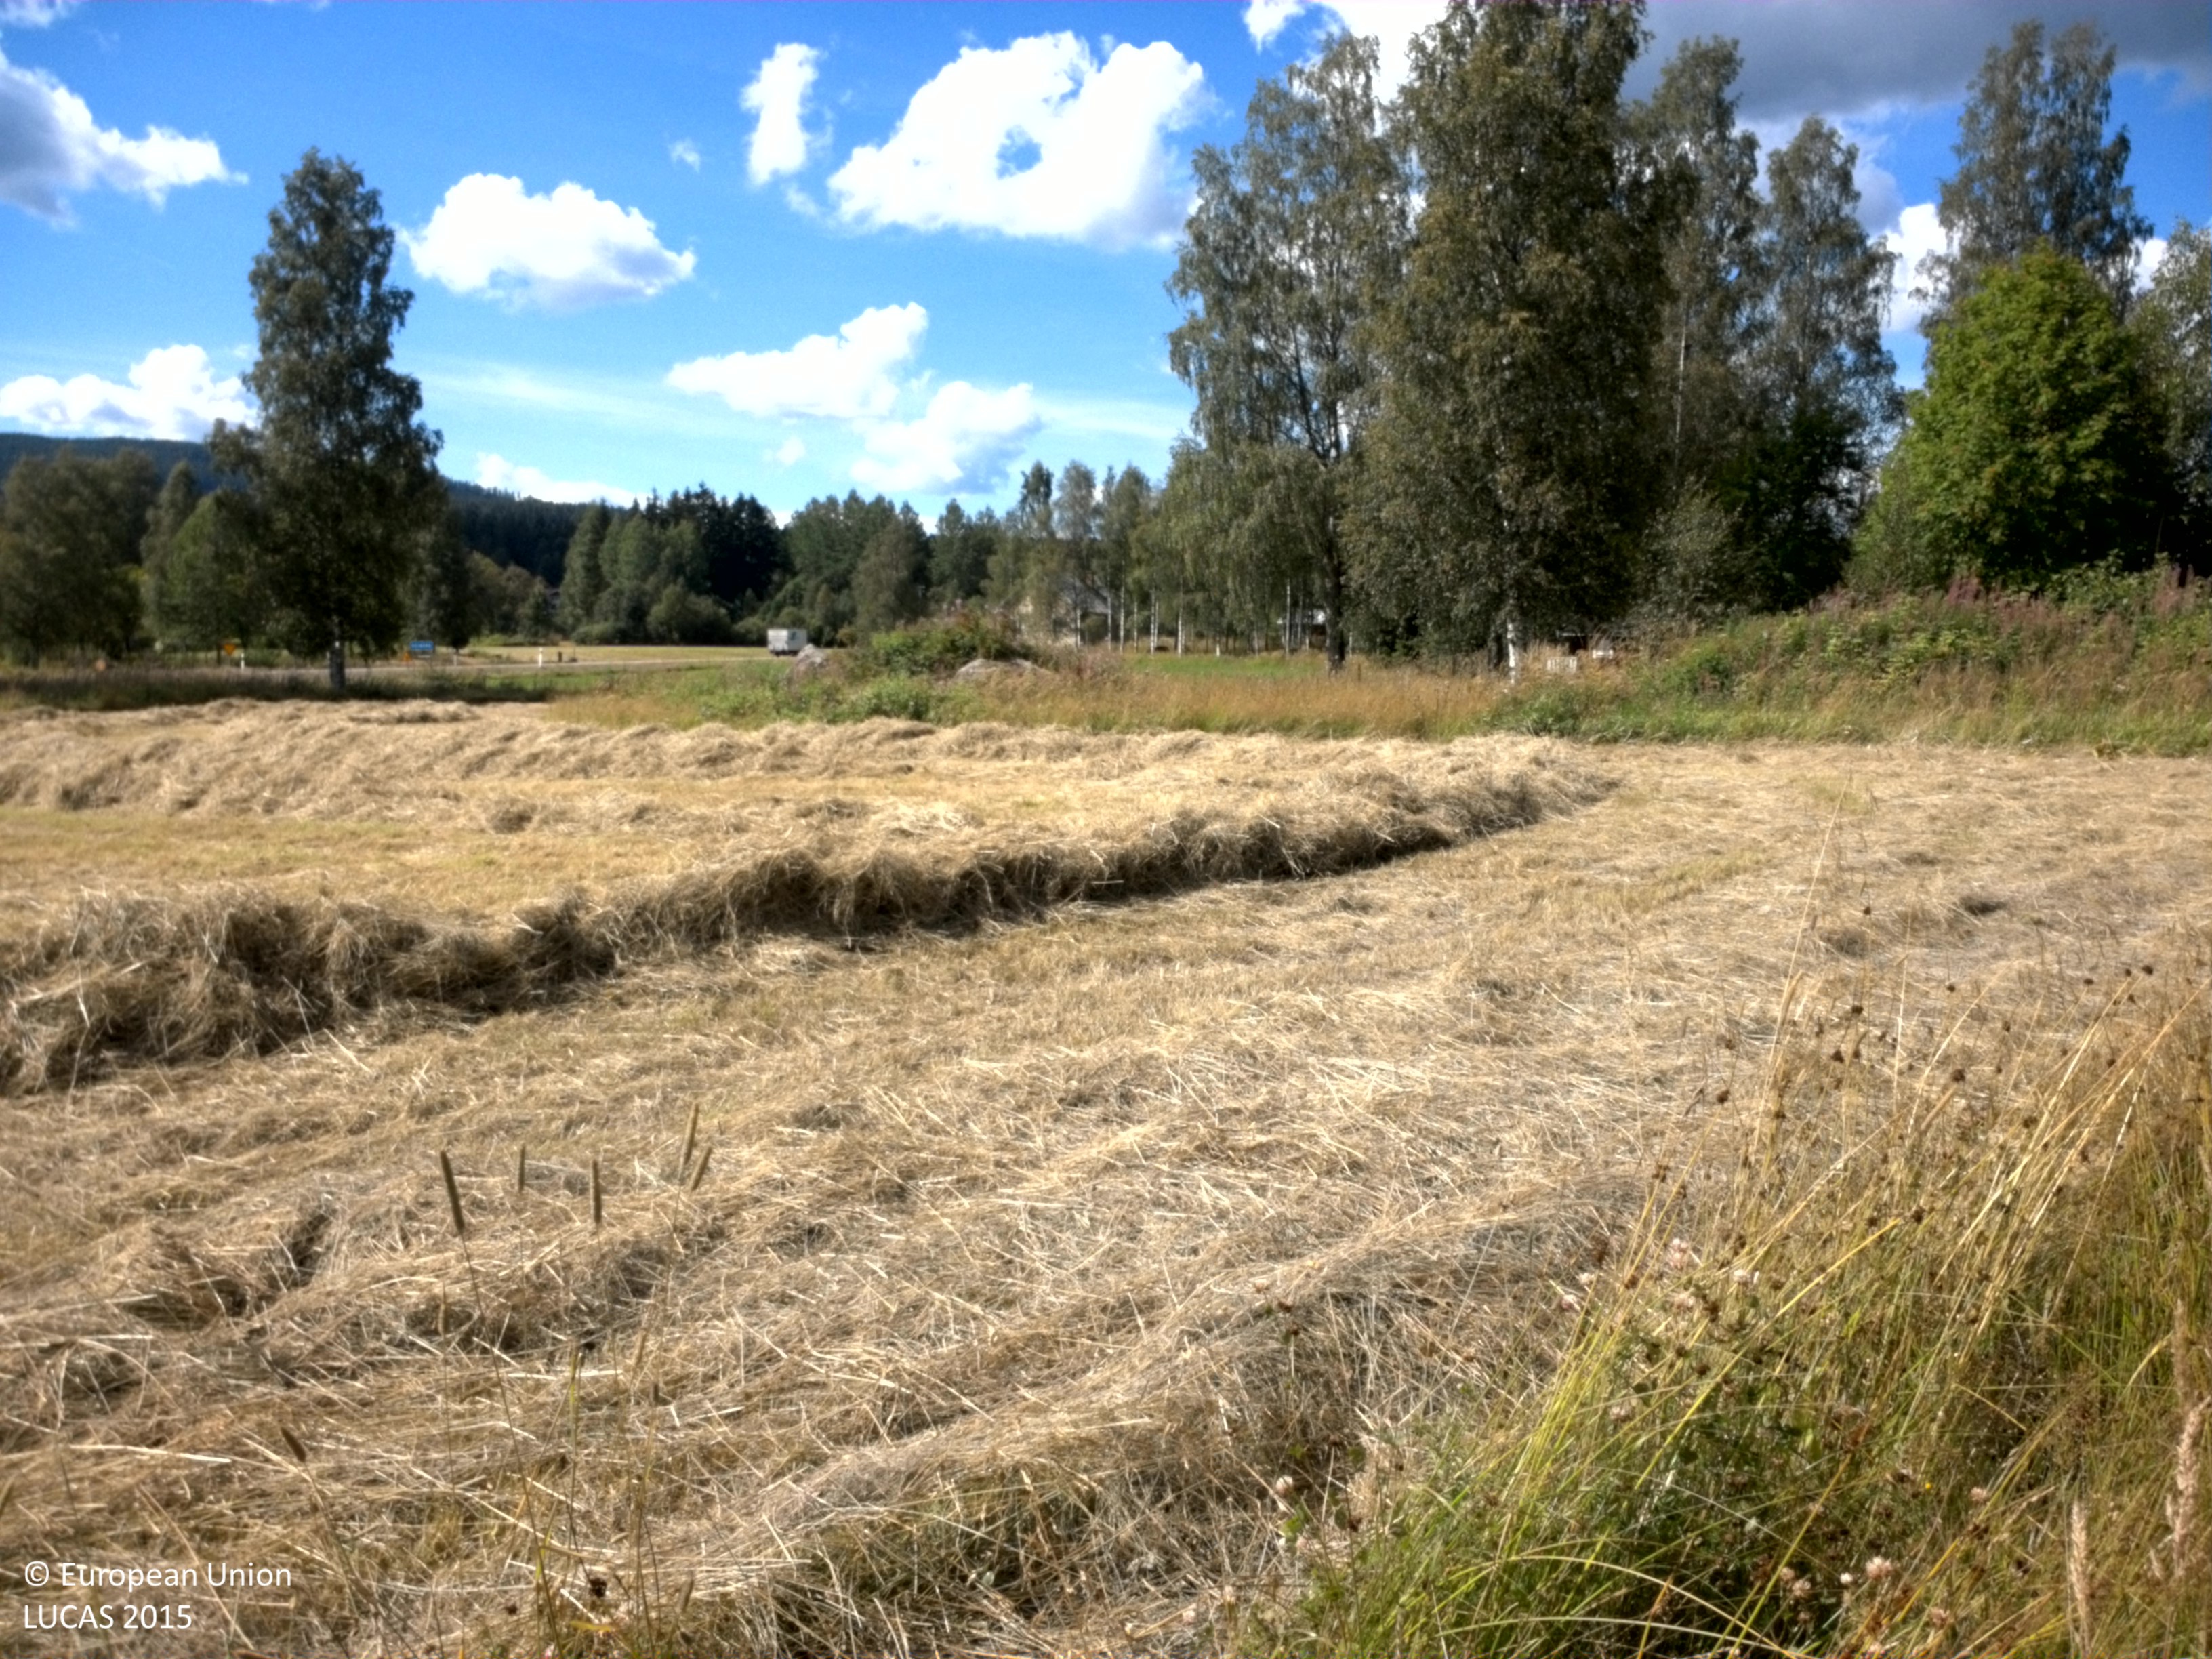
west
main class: Grassland
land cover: Grassland with sparse tree/shrub cover
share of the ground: > 75 %
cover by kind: herbaceous plants 85 %, shrubs 10 %, broadleaved forest trees 5 %
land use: Semi-natural and natural areas not in use
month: August
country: SE
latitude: 60.1758
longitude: 13.3975
